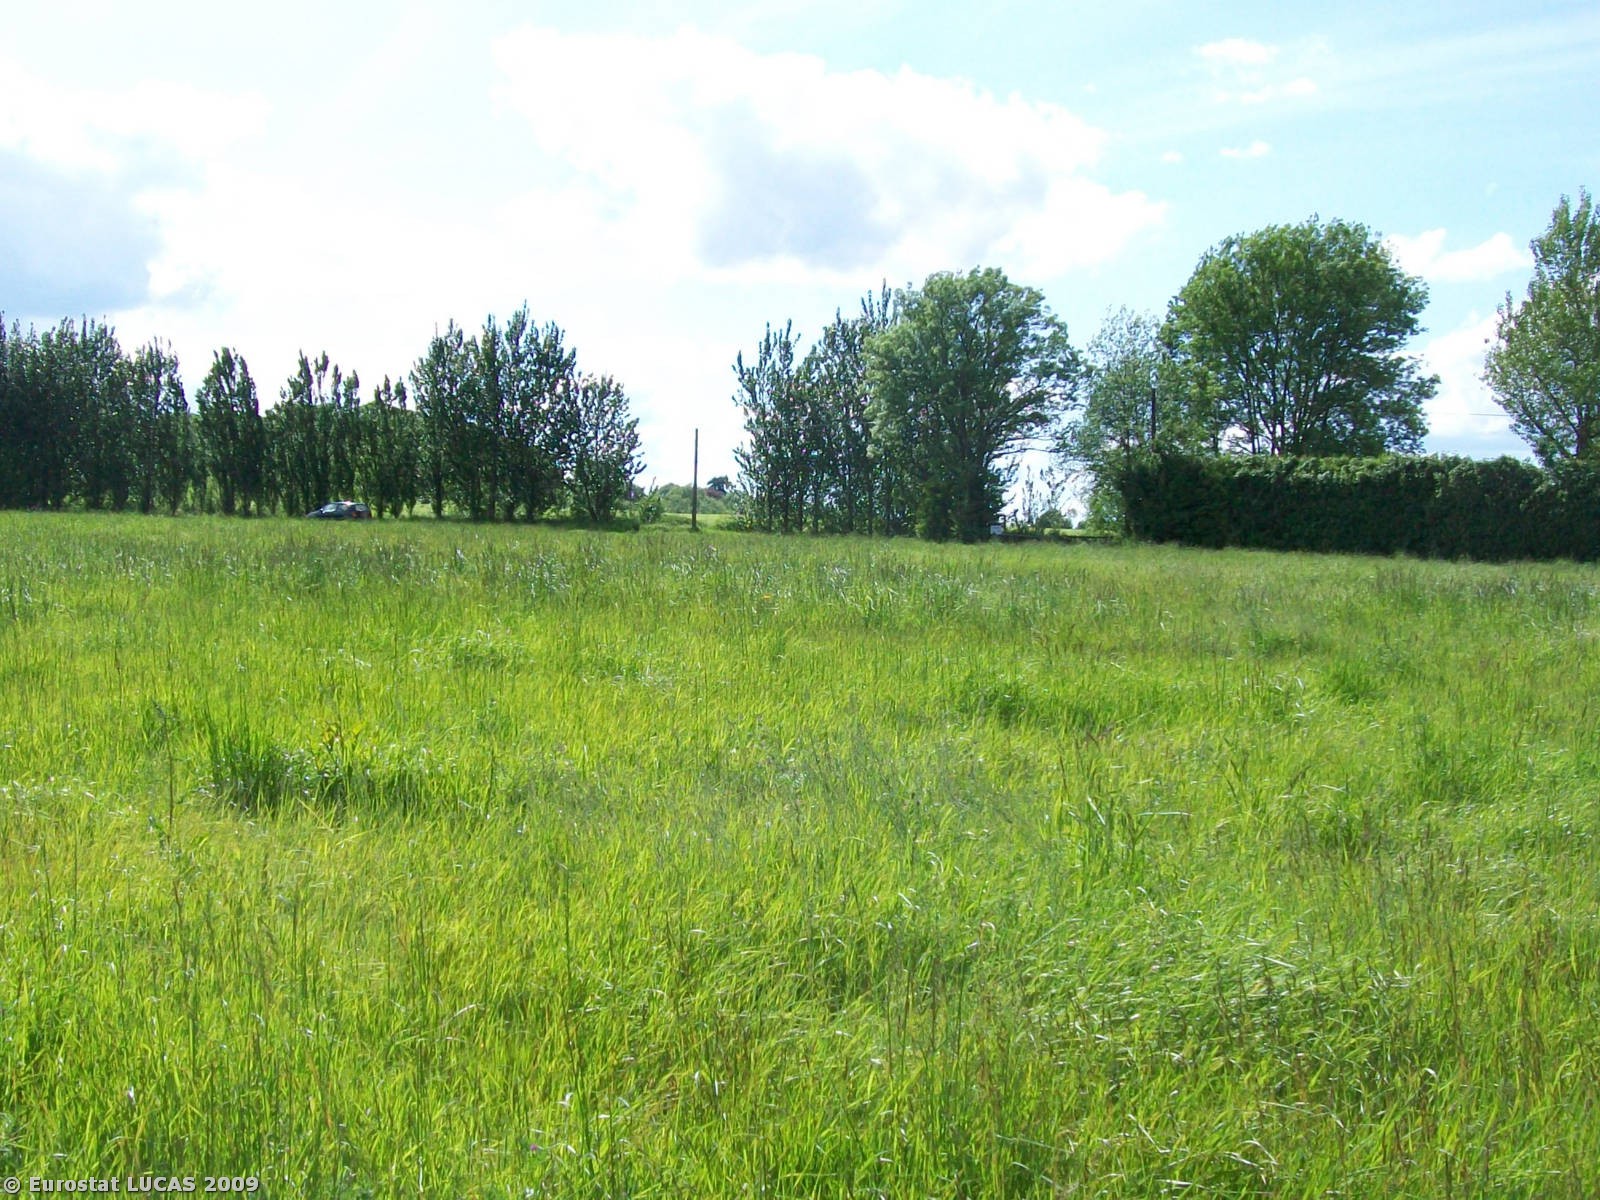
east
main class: Grassland
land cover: Grassland without tree/shrub cover
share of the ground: > 75 %
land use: Agriculture (excluding fallow land and kitchen gardens)
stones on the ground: < 10 %
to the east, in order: Grassland without tree/shrub cover; Managed hedges; Rivers and streams; Arable land (only in case pi)
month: May
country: GB
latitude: 51.1836
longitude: 0.3135
